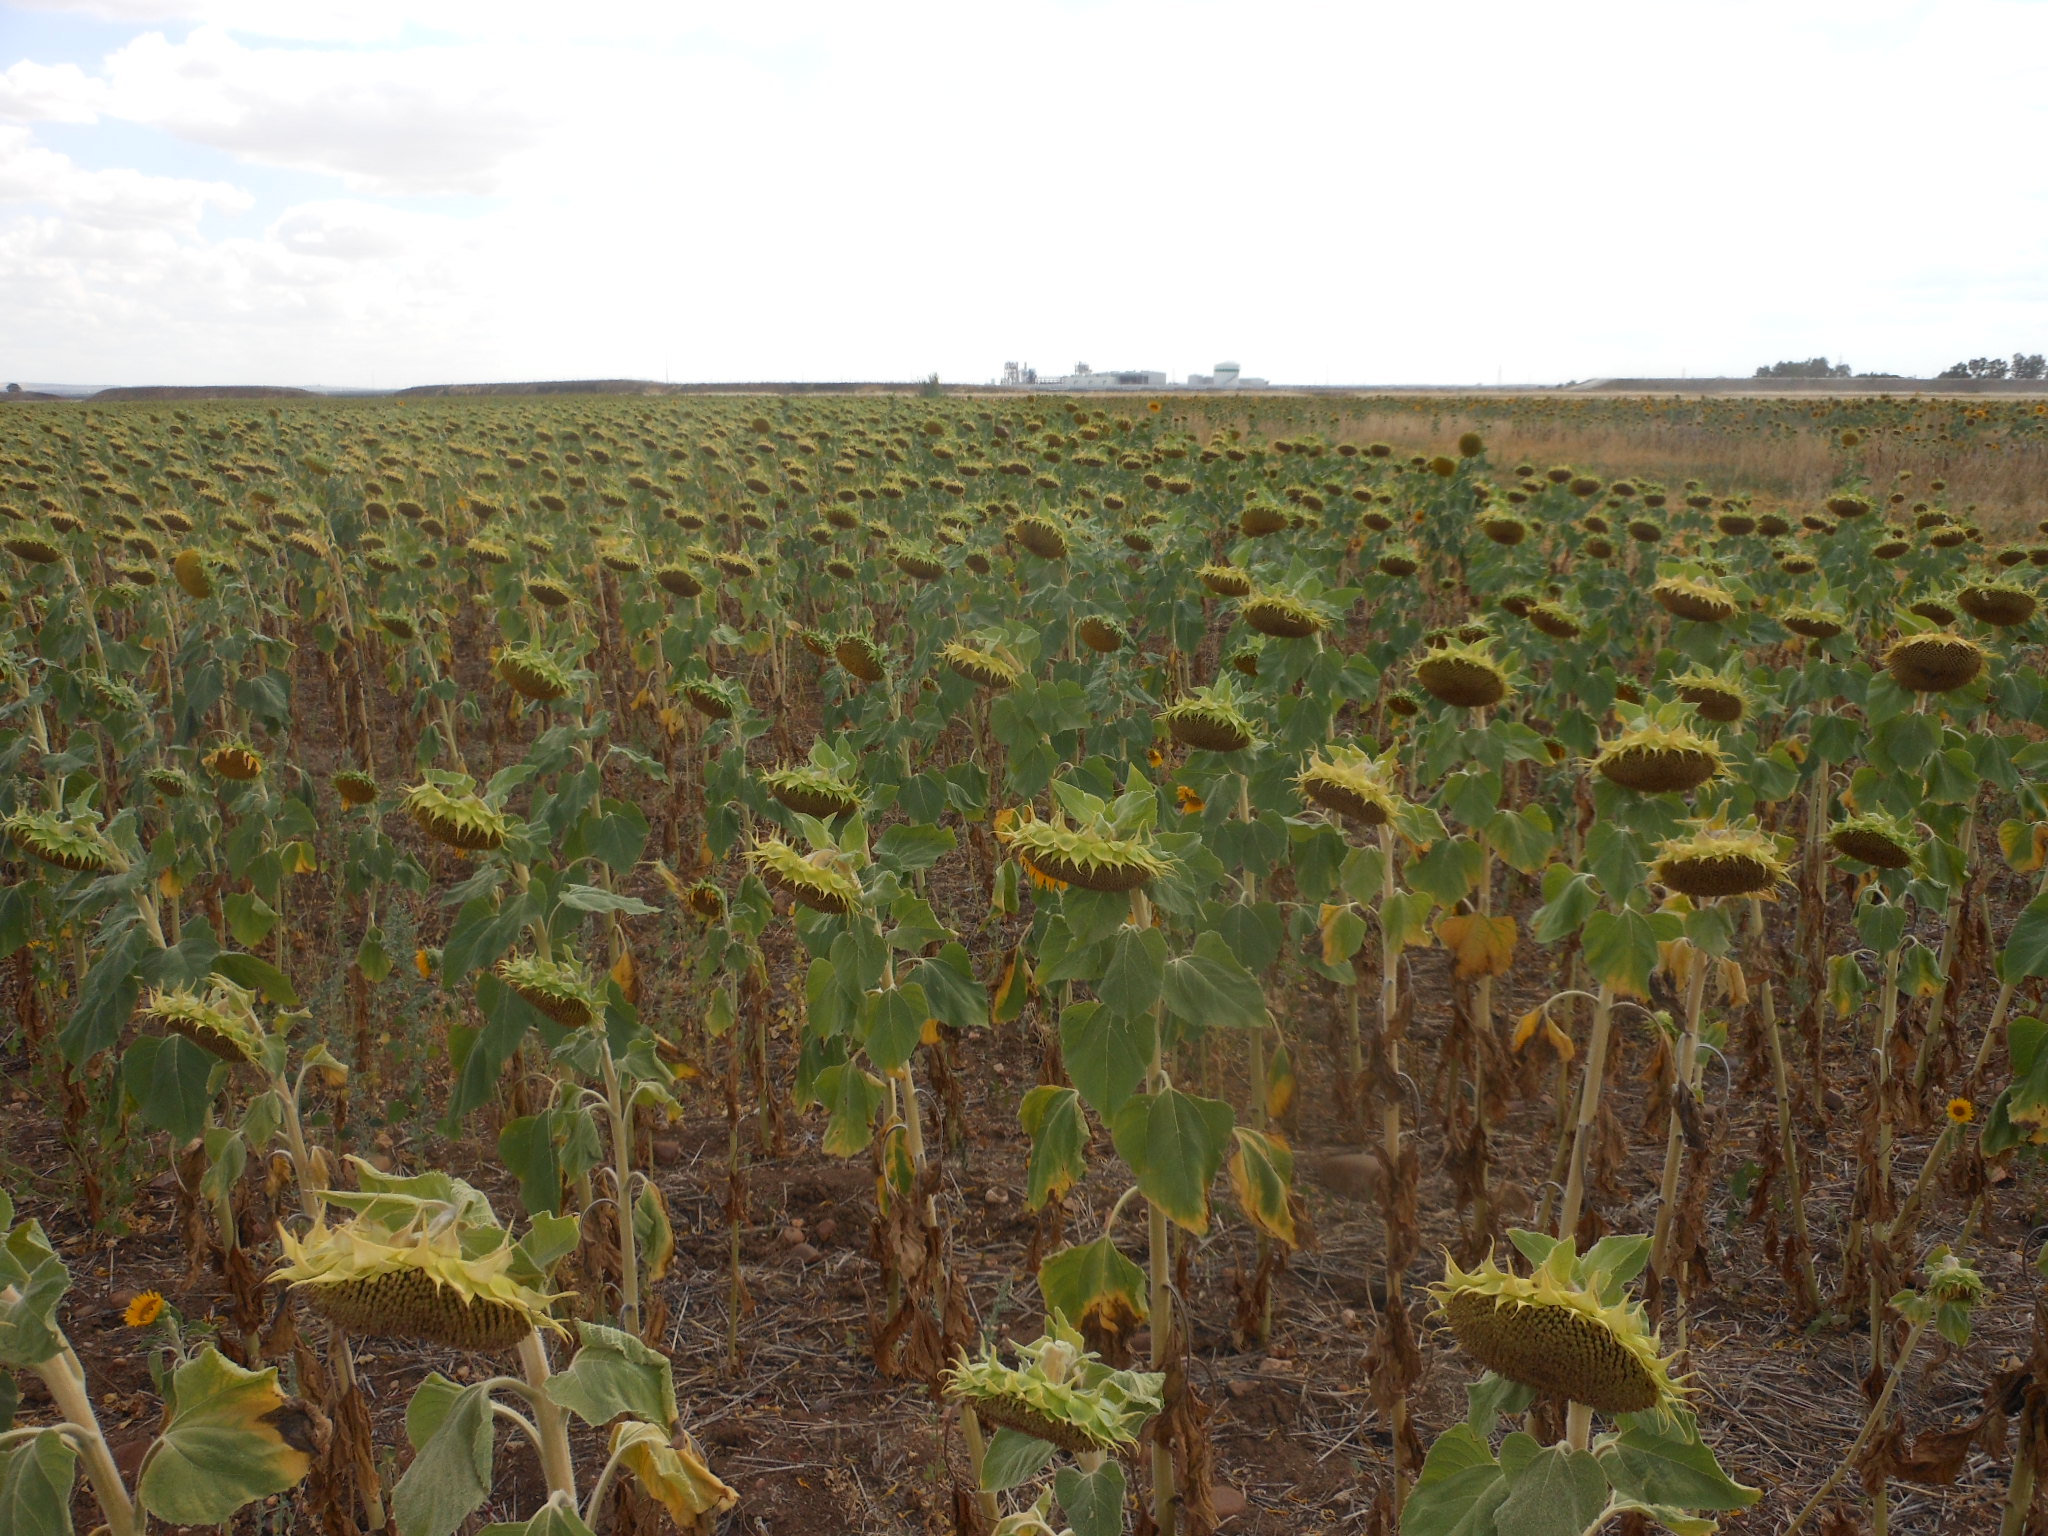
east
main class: Cropland
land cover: Sunflower
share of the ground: > 75 %
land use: Agriculture (excluding fallow land and kitchen gardens)
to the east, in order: Sunflower; Rivers and streams; Sunflower; Grass margins; Sunflower
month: June
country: ES
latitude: 37.5785
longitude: -5.1307
